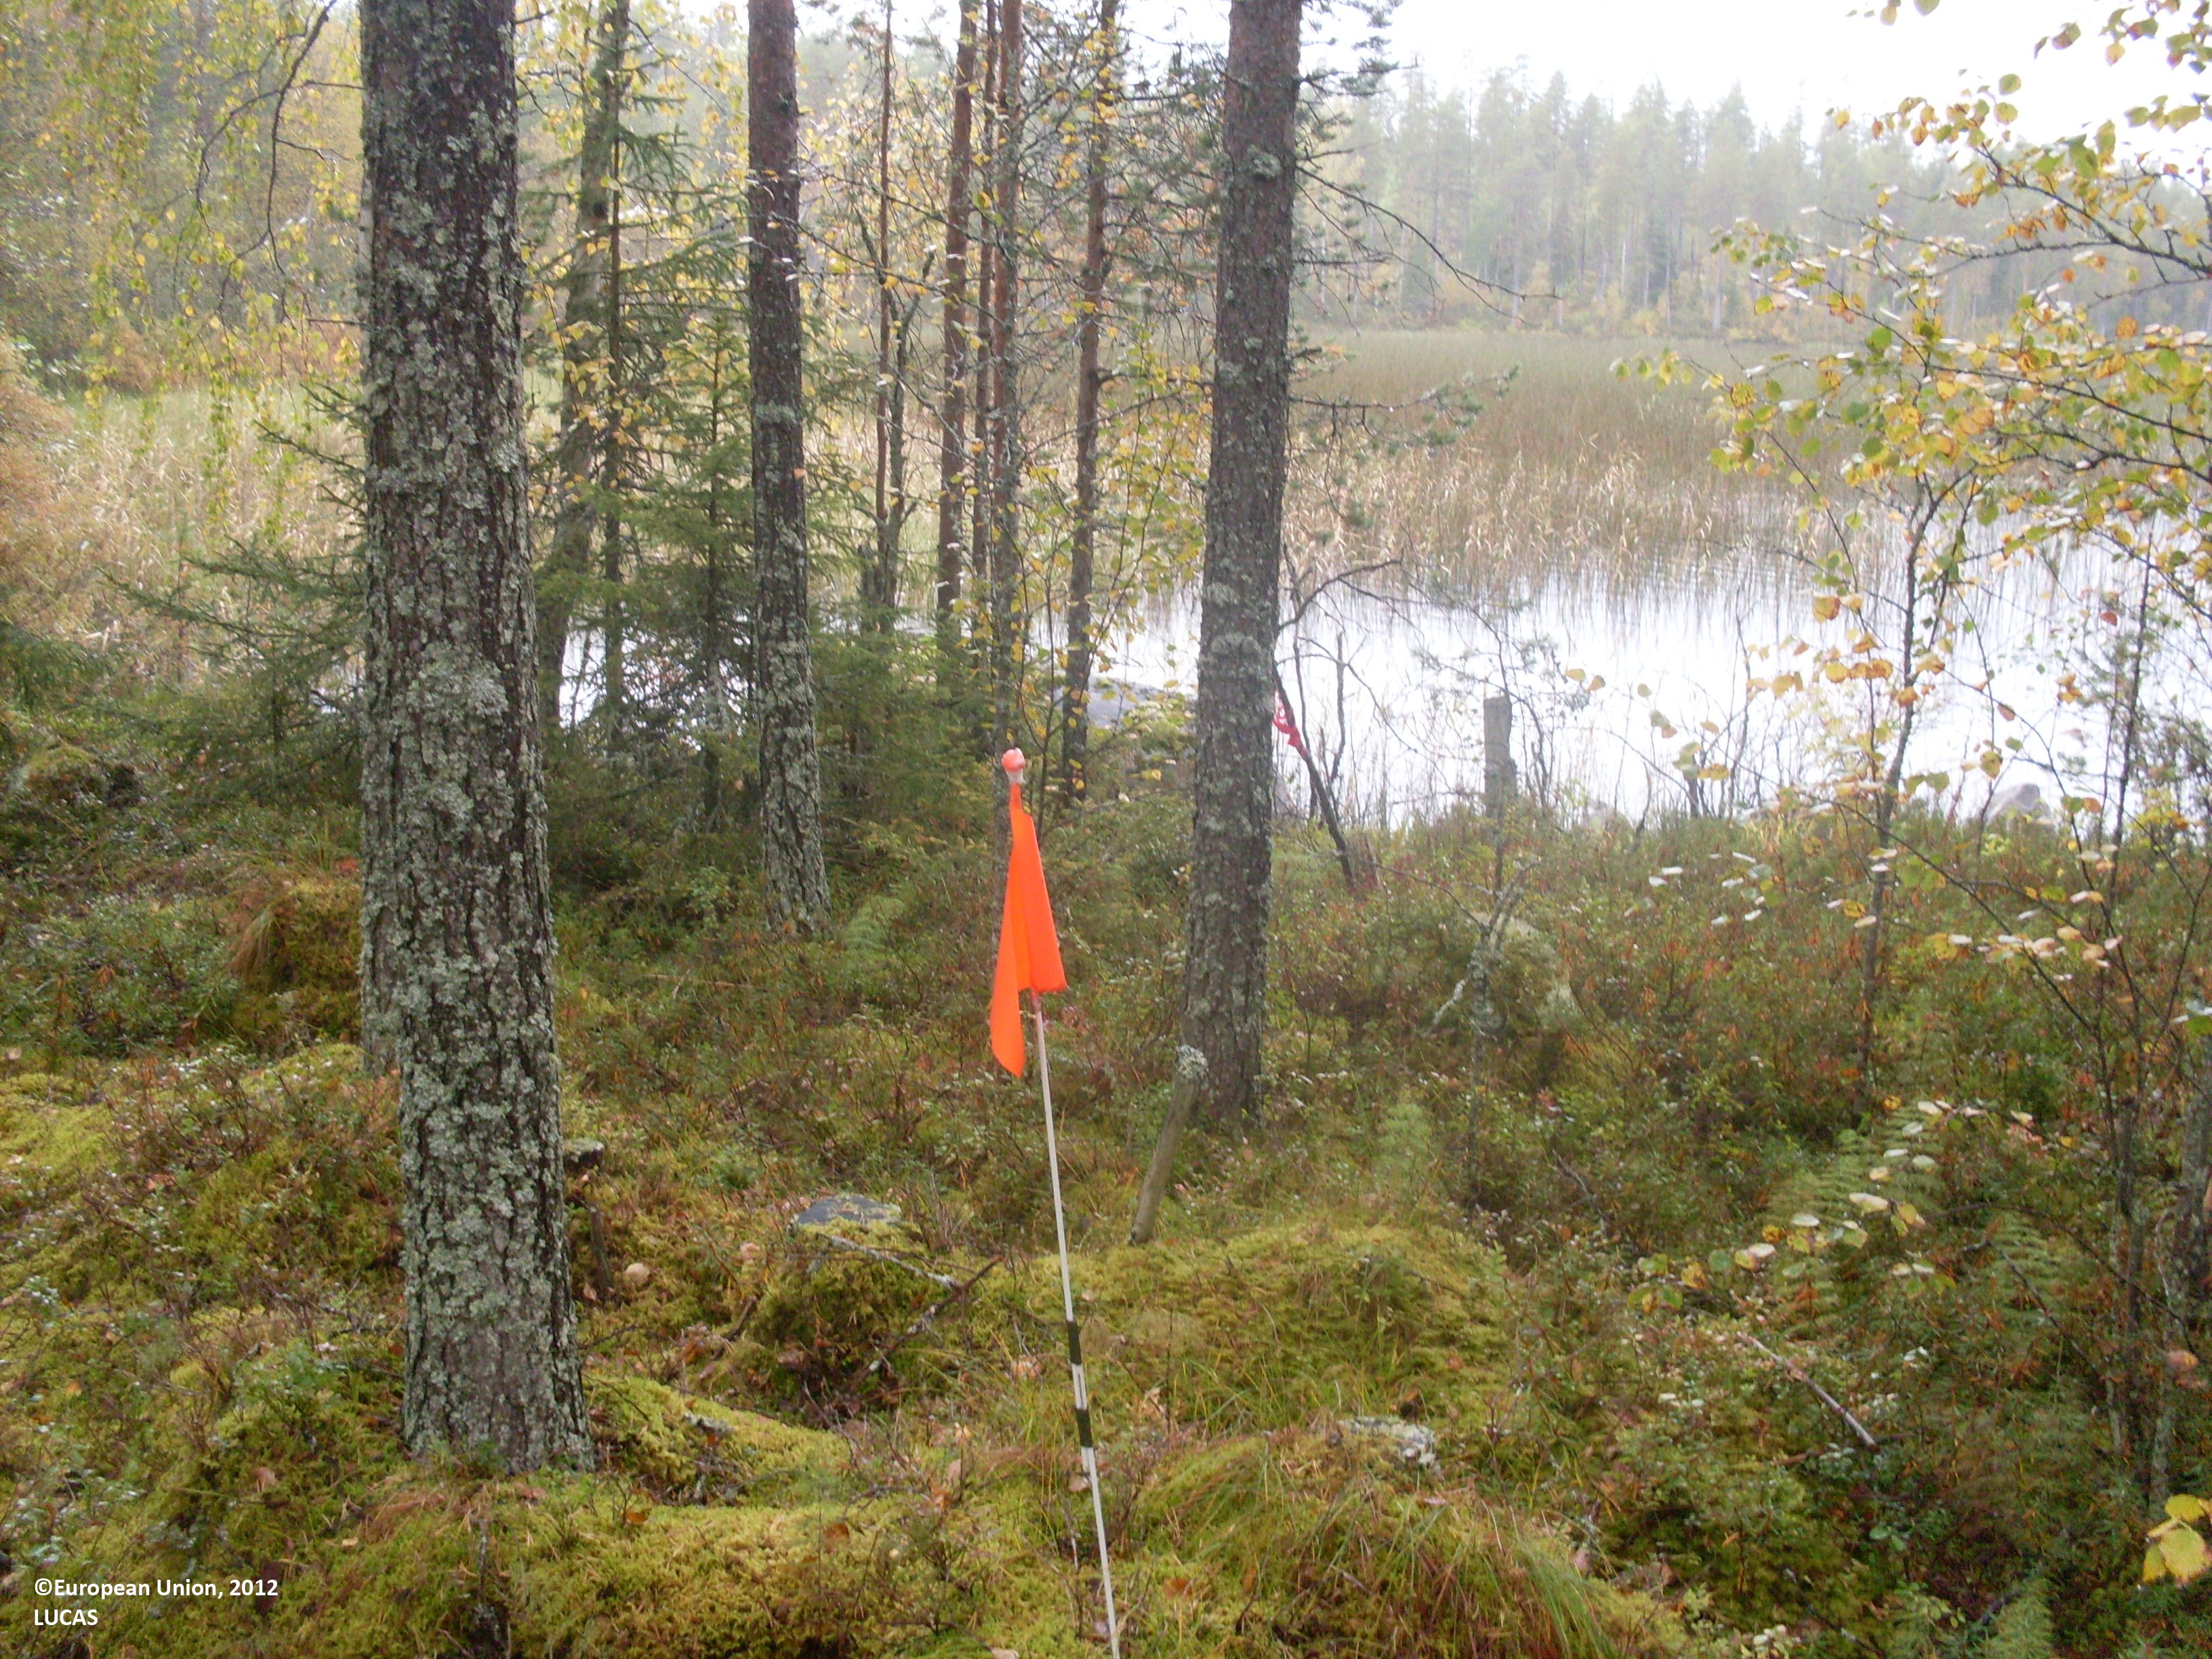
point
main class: Woodland
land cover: Pine dominated mixed woodland
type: boreal forest
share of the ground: > 75 %
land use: Forestry
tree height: > 5 m
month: September
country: FI
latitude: 64.0150
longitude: 30.1946
